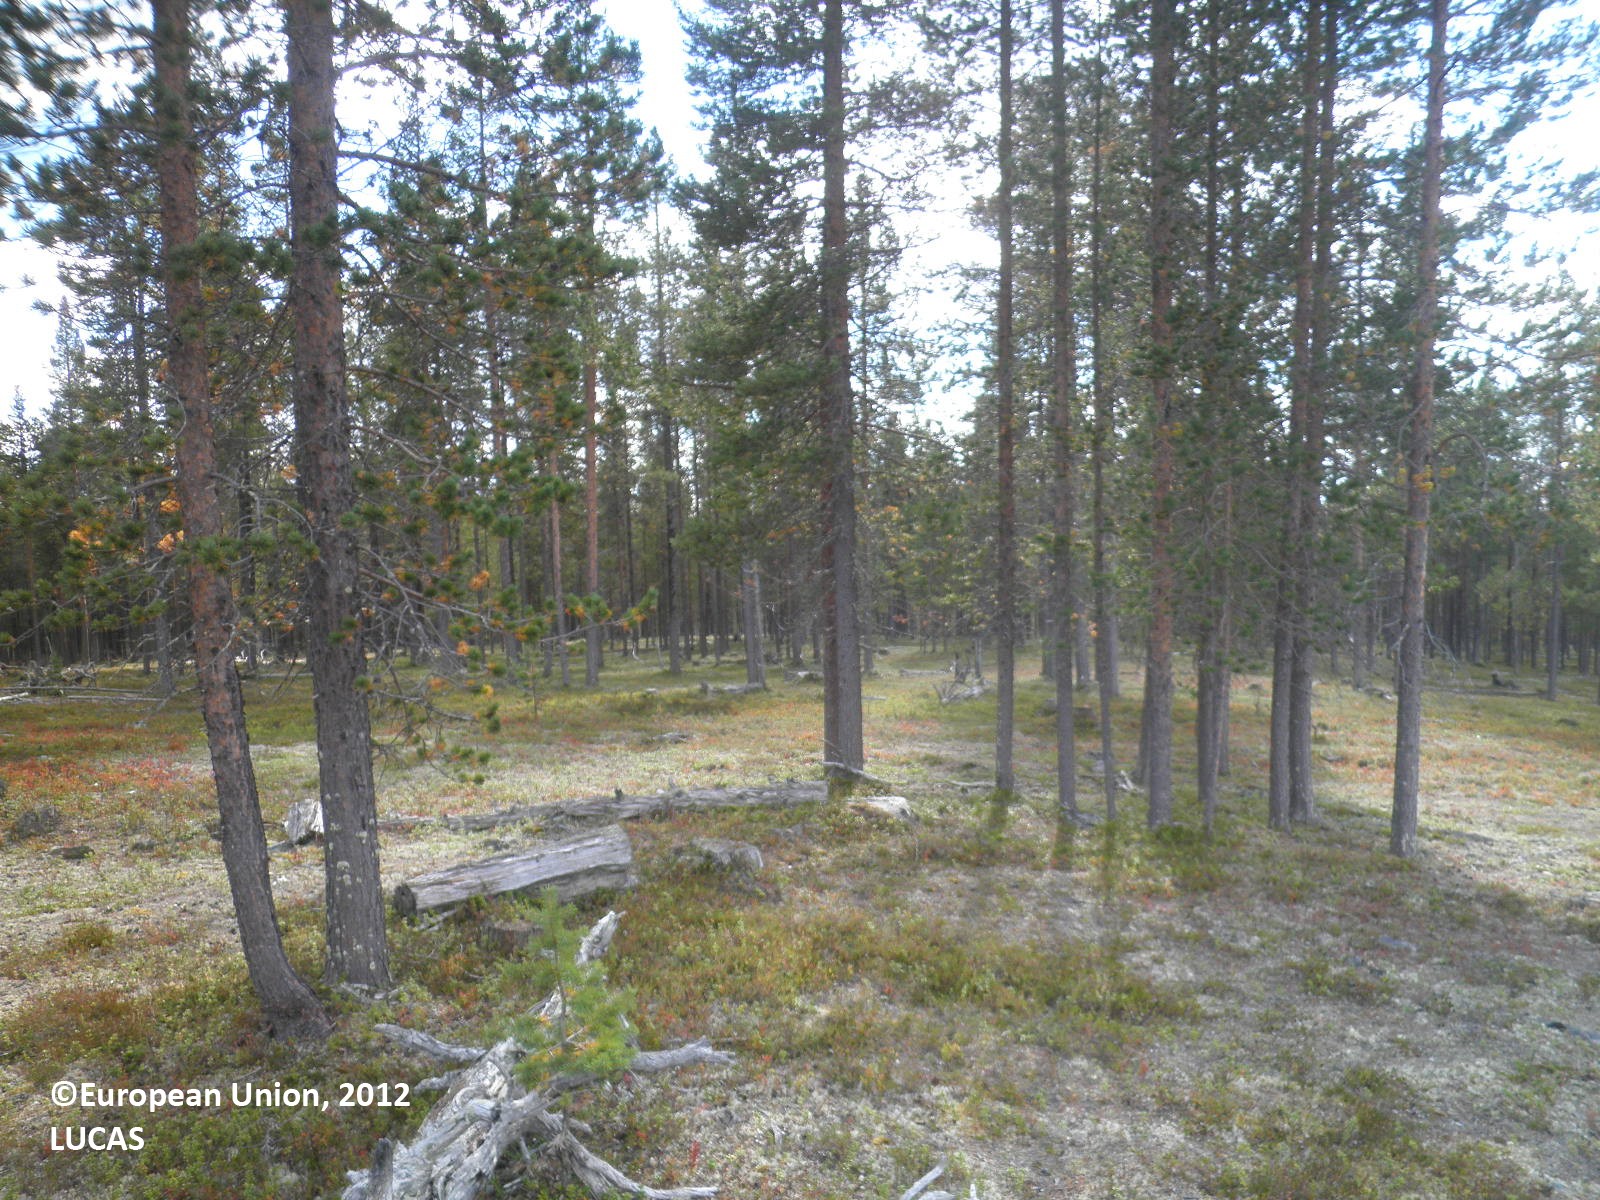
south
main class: Shrubland
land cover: Shrubland with sparse tree cover
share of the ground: > 75 %
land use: Forestry
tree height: > 5 m
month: August
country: FI
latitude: 68.0224
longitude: 28.2360
